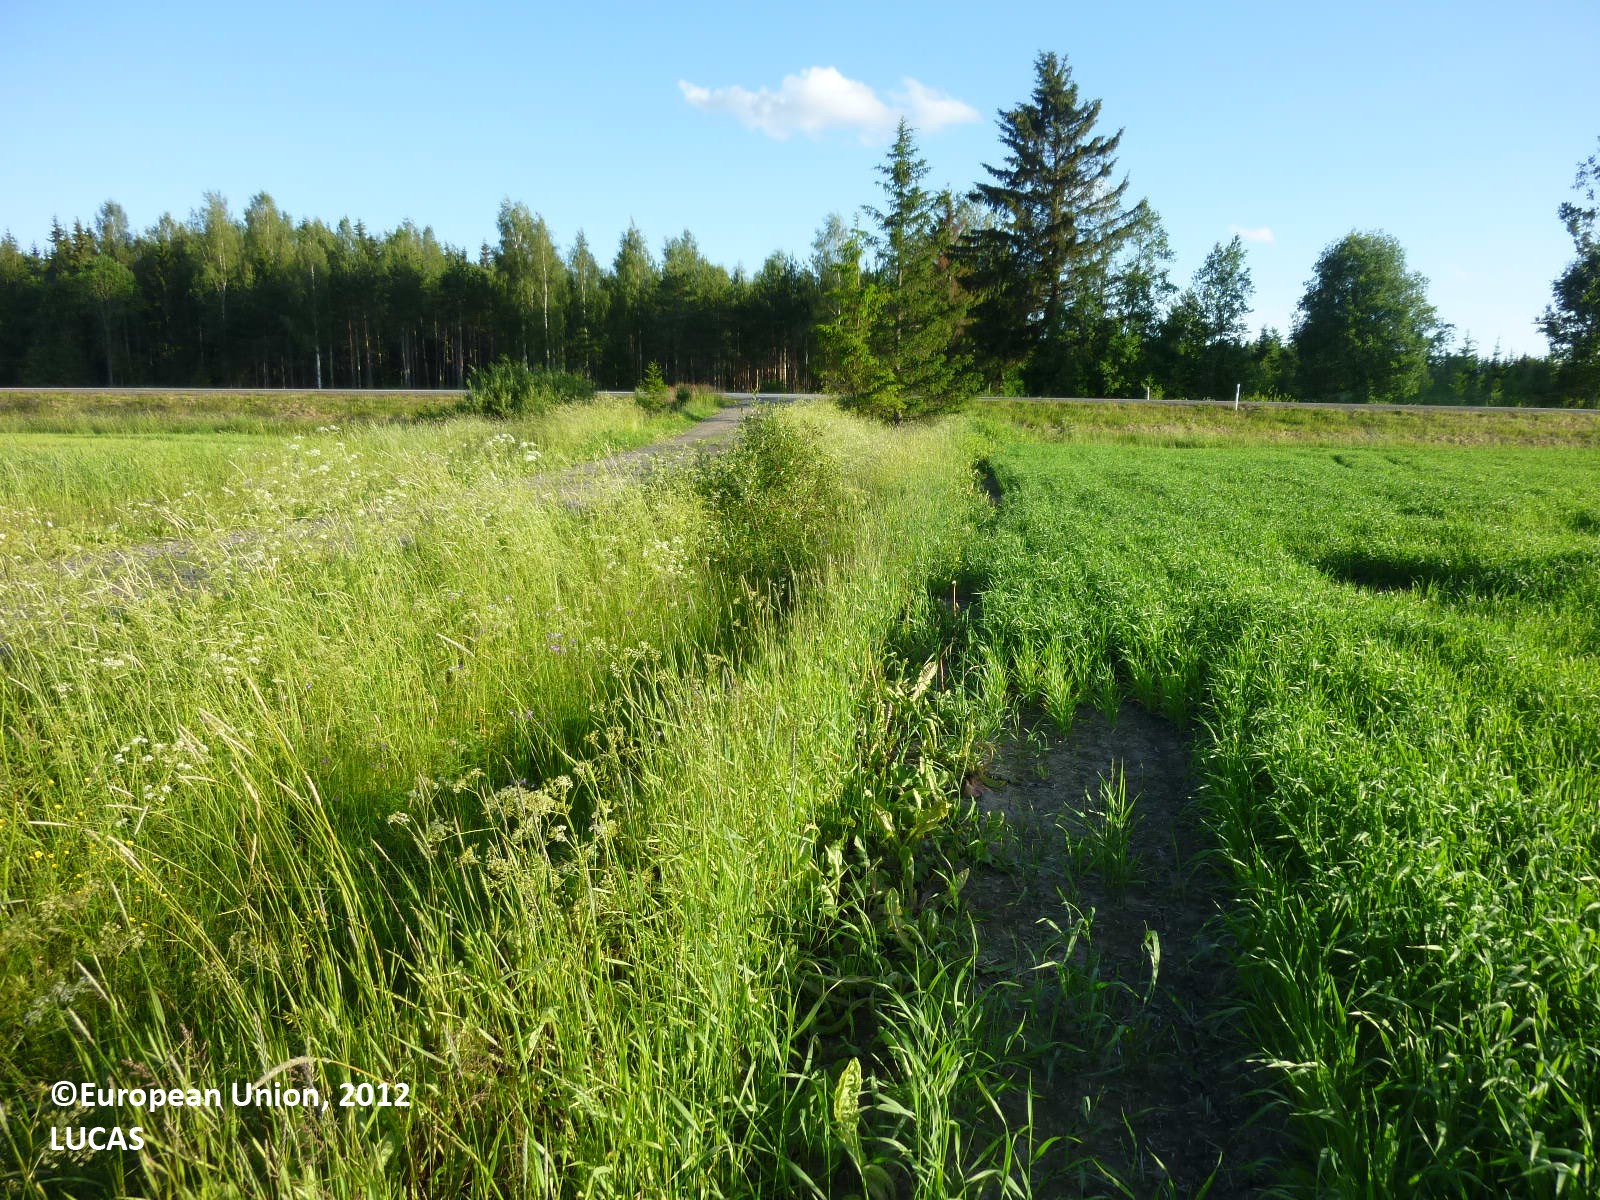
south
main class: Cropland
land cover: Barley
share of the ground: > 75 %
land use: Agriculture (excluding fallow land and kitchen gardens)
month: July
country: FI
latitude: 61.1920
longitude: 22.5113
